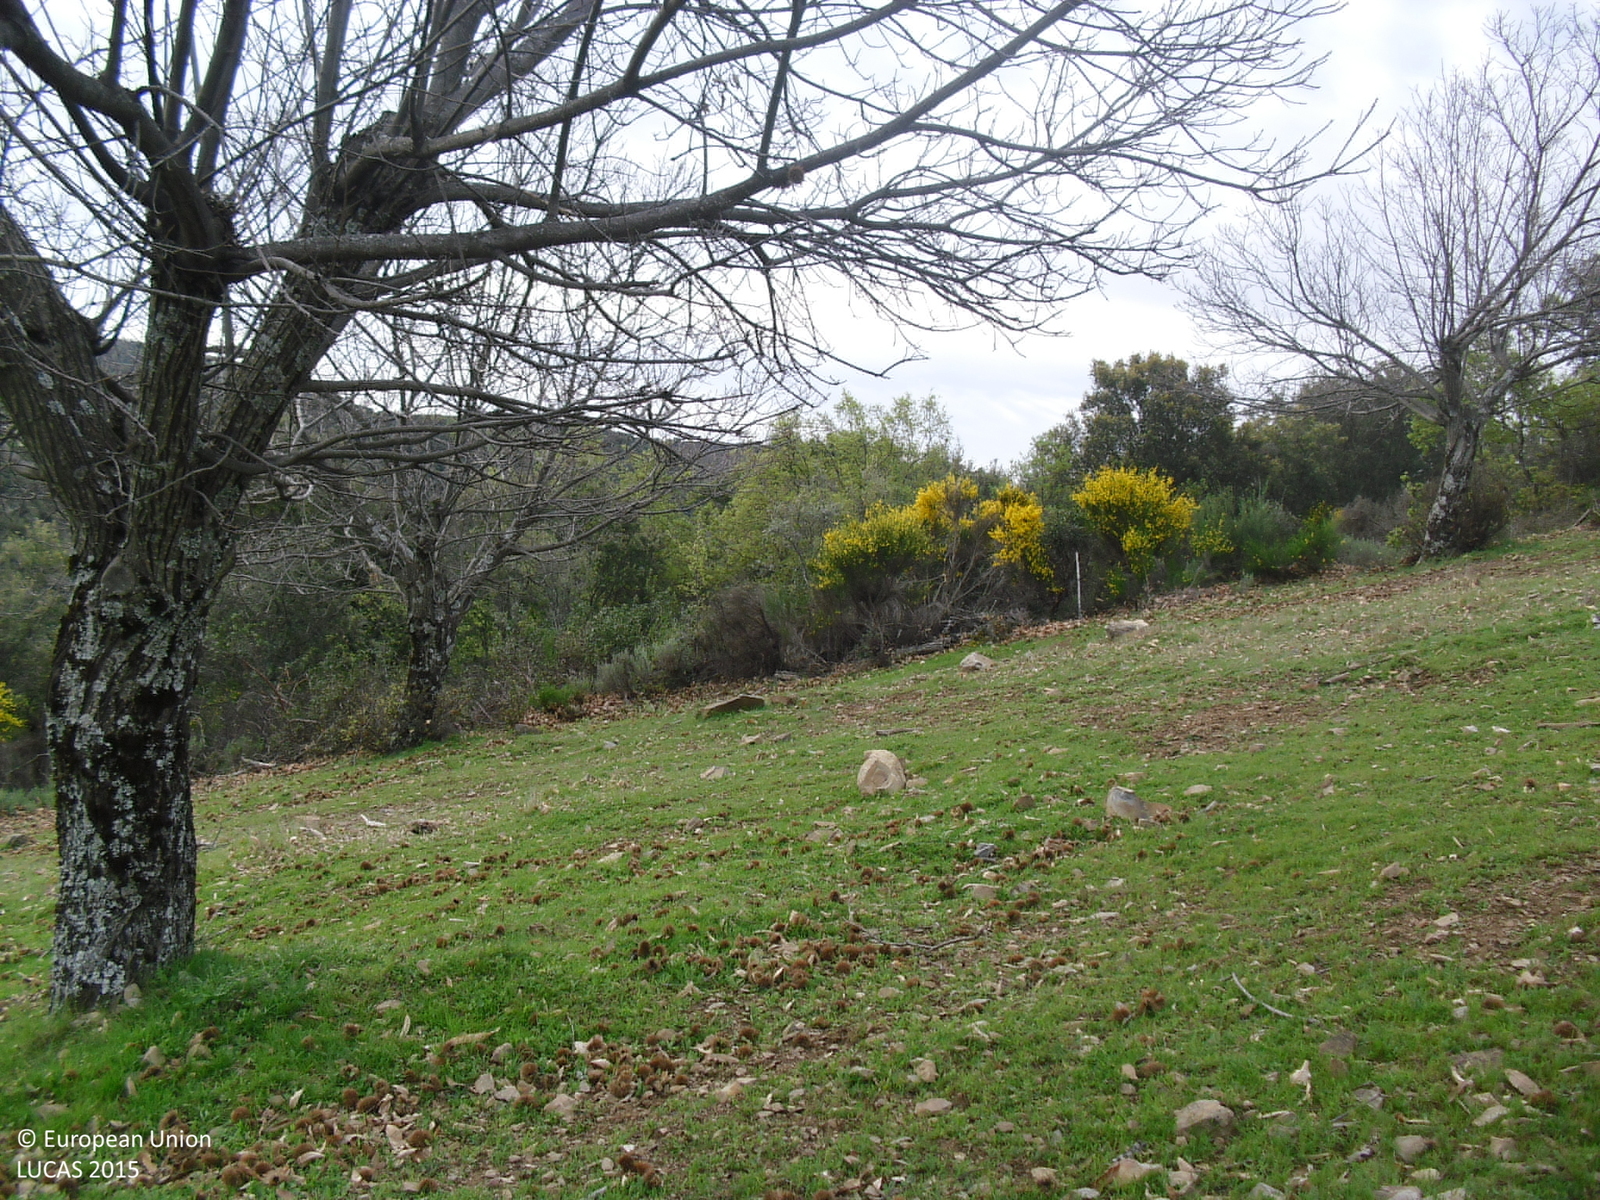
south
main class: Woodland
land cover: Broadleaved woodland
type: thermophilous deciduous forest
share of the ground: 25 - 50 %
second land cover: Grassland without tree/shrub cover
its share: > 75 %
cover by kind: herbaceous plants 60 %, broadleaved forest trees 40 %
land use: Forestry
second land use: Agriculture (excluding fallow land and kitchen gardens)
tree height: > 5 m
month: April
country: ES
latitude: 39.5154
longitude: -5.3212
